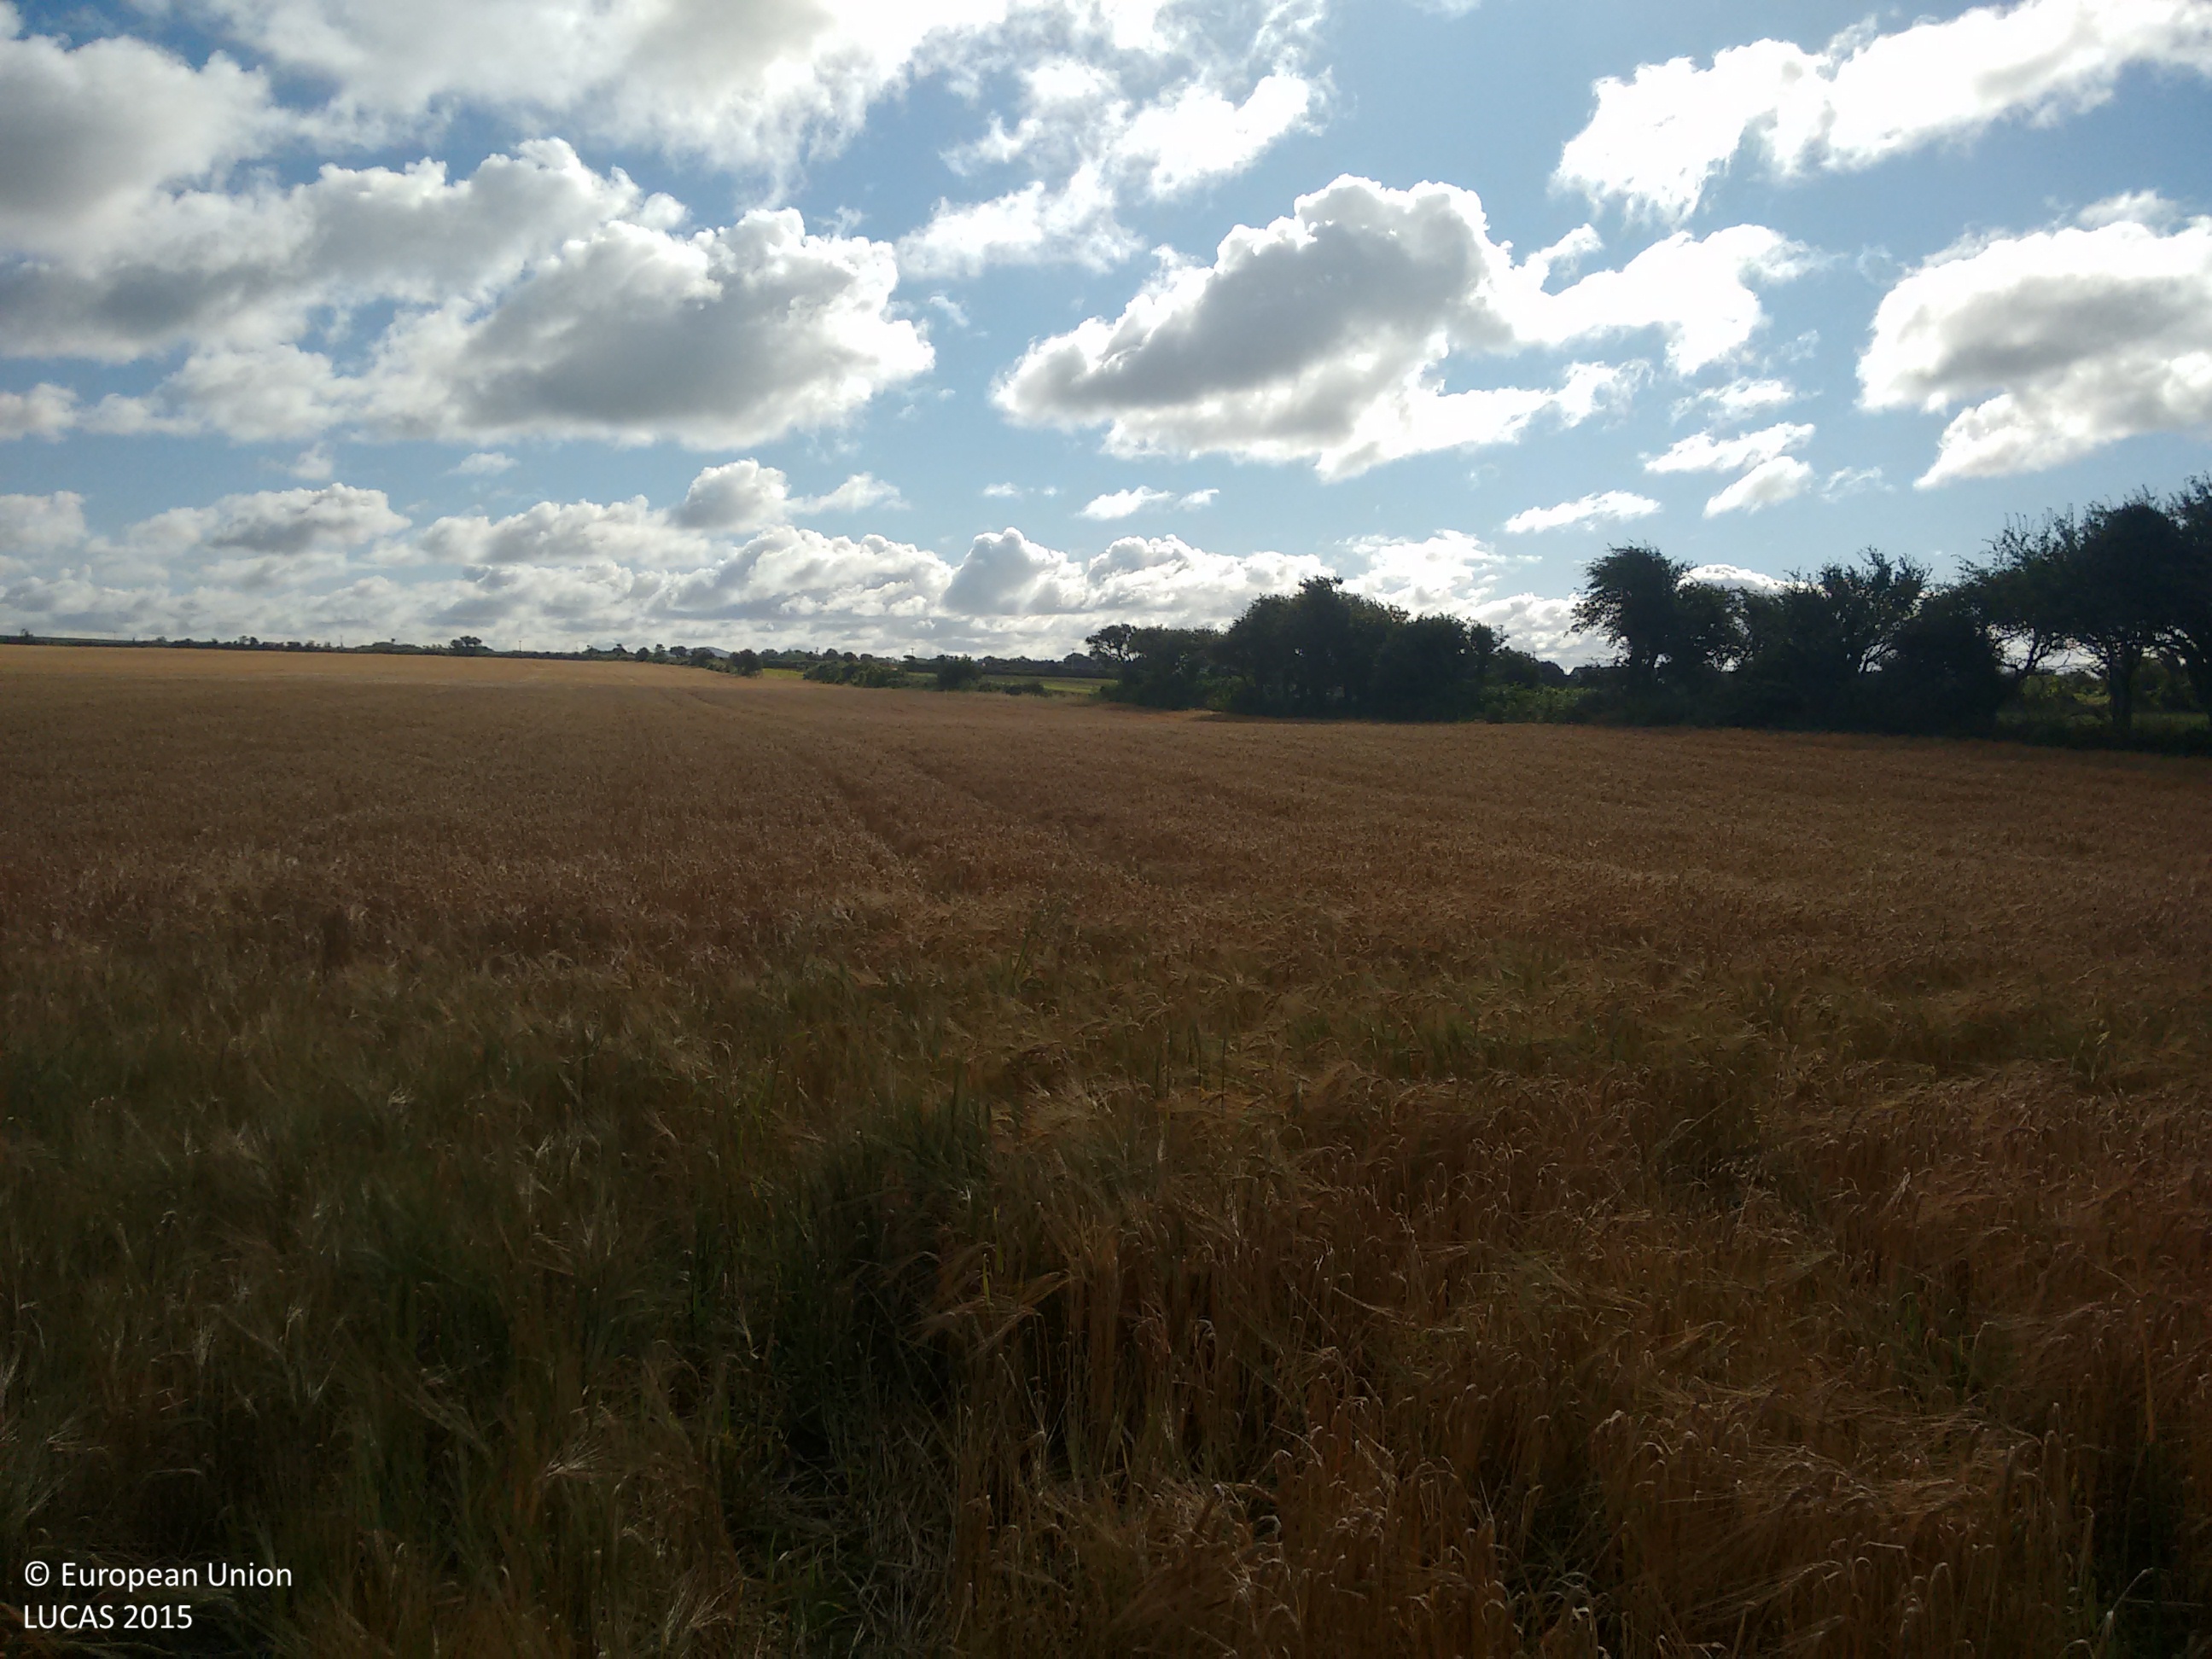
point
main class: Cropland
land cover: Barley
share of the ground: > 75 %
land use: Agriculture (excluding fallow land and kitchen gardens)
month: September
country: IE
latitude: 52.3165
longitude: -9.8003
